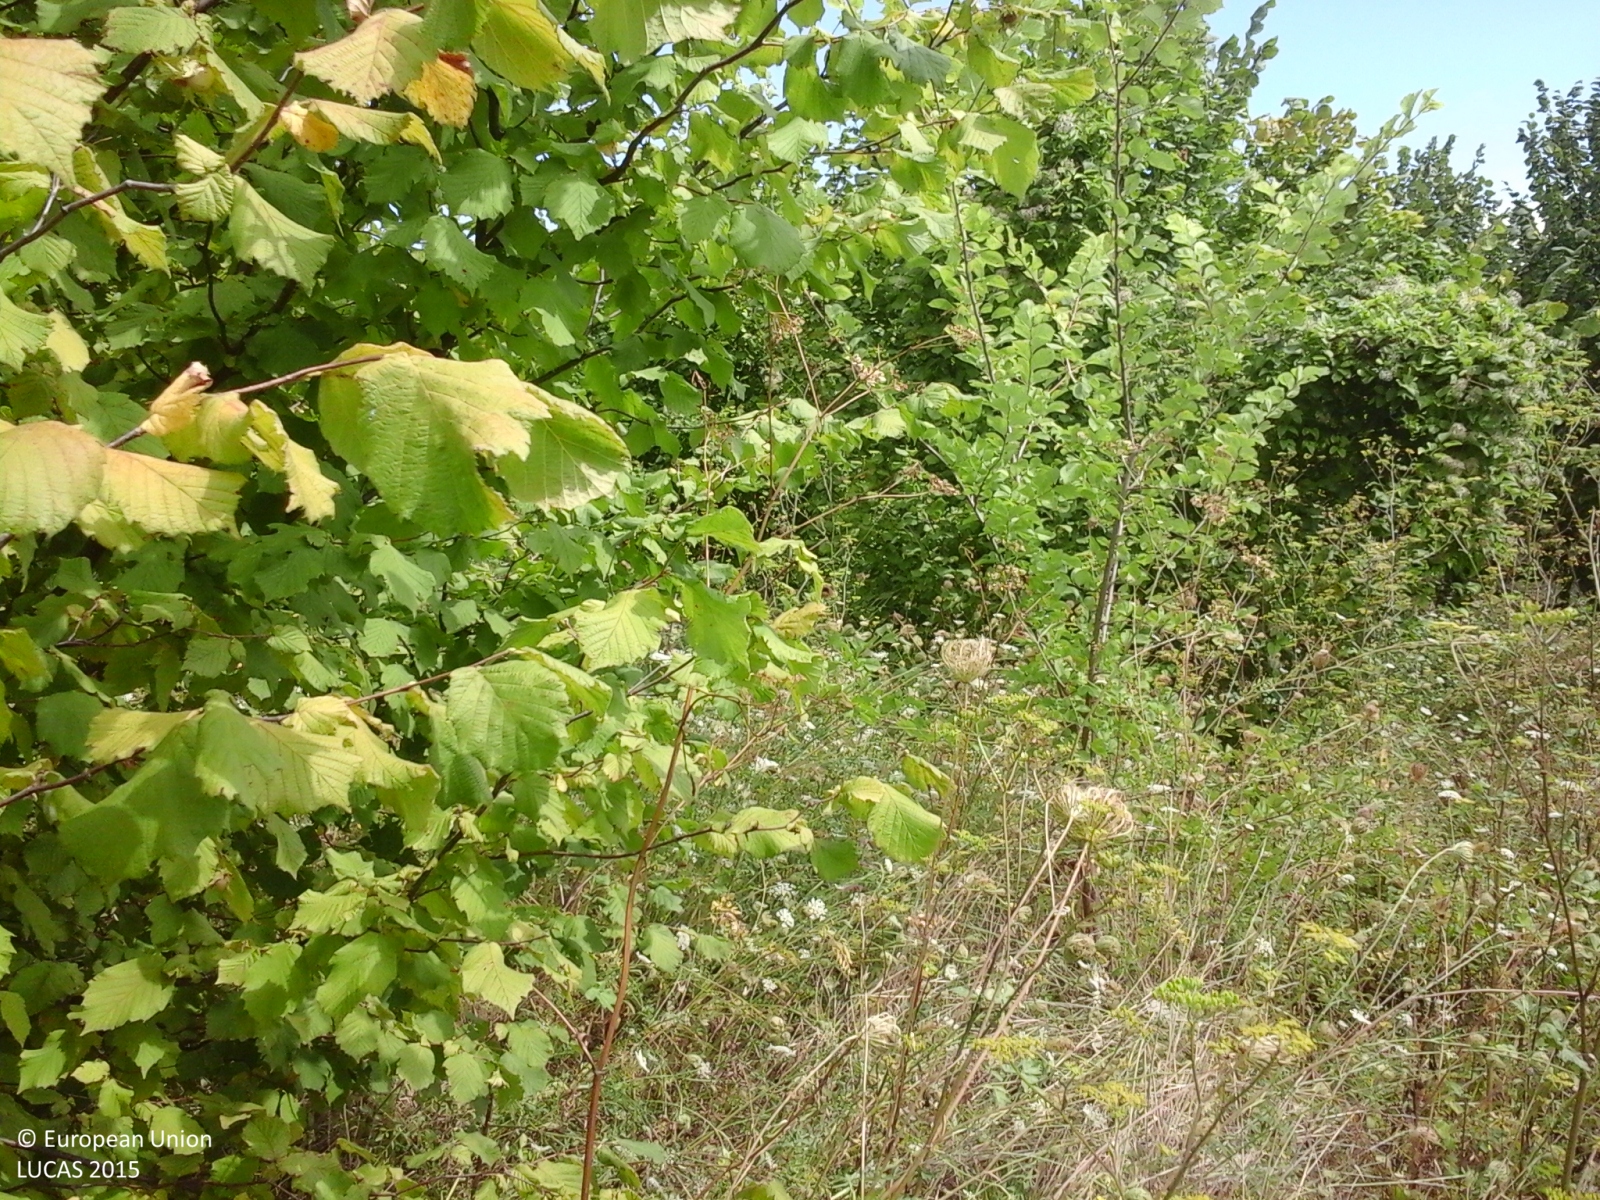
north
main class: Cropland
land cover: Nuts trees
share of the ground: > 75 %
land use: Agriculture (excluding fallow land and kitchen gardens)
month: August
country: IT
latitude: 43.3447
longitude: 13.1867
